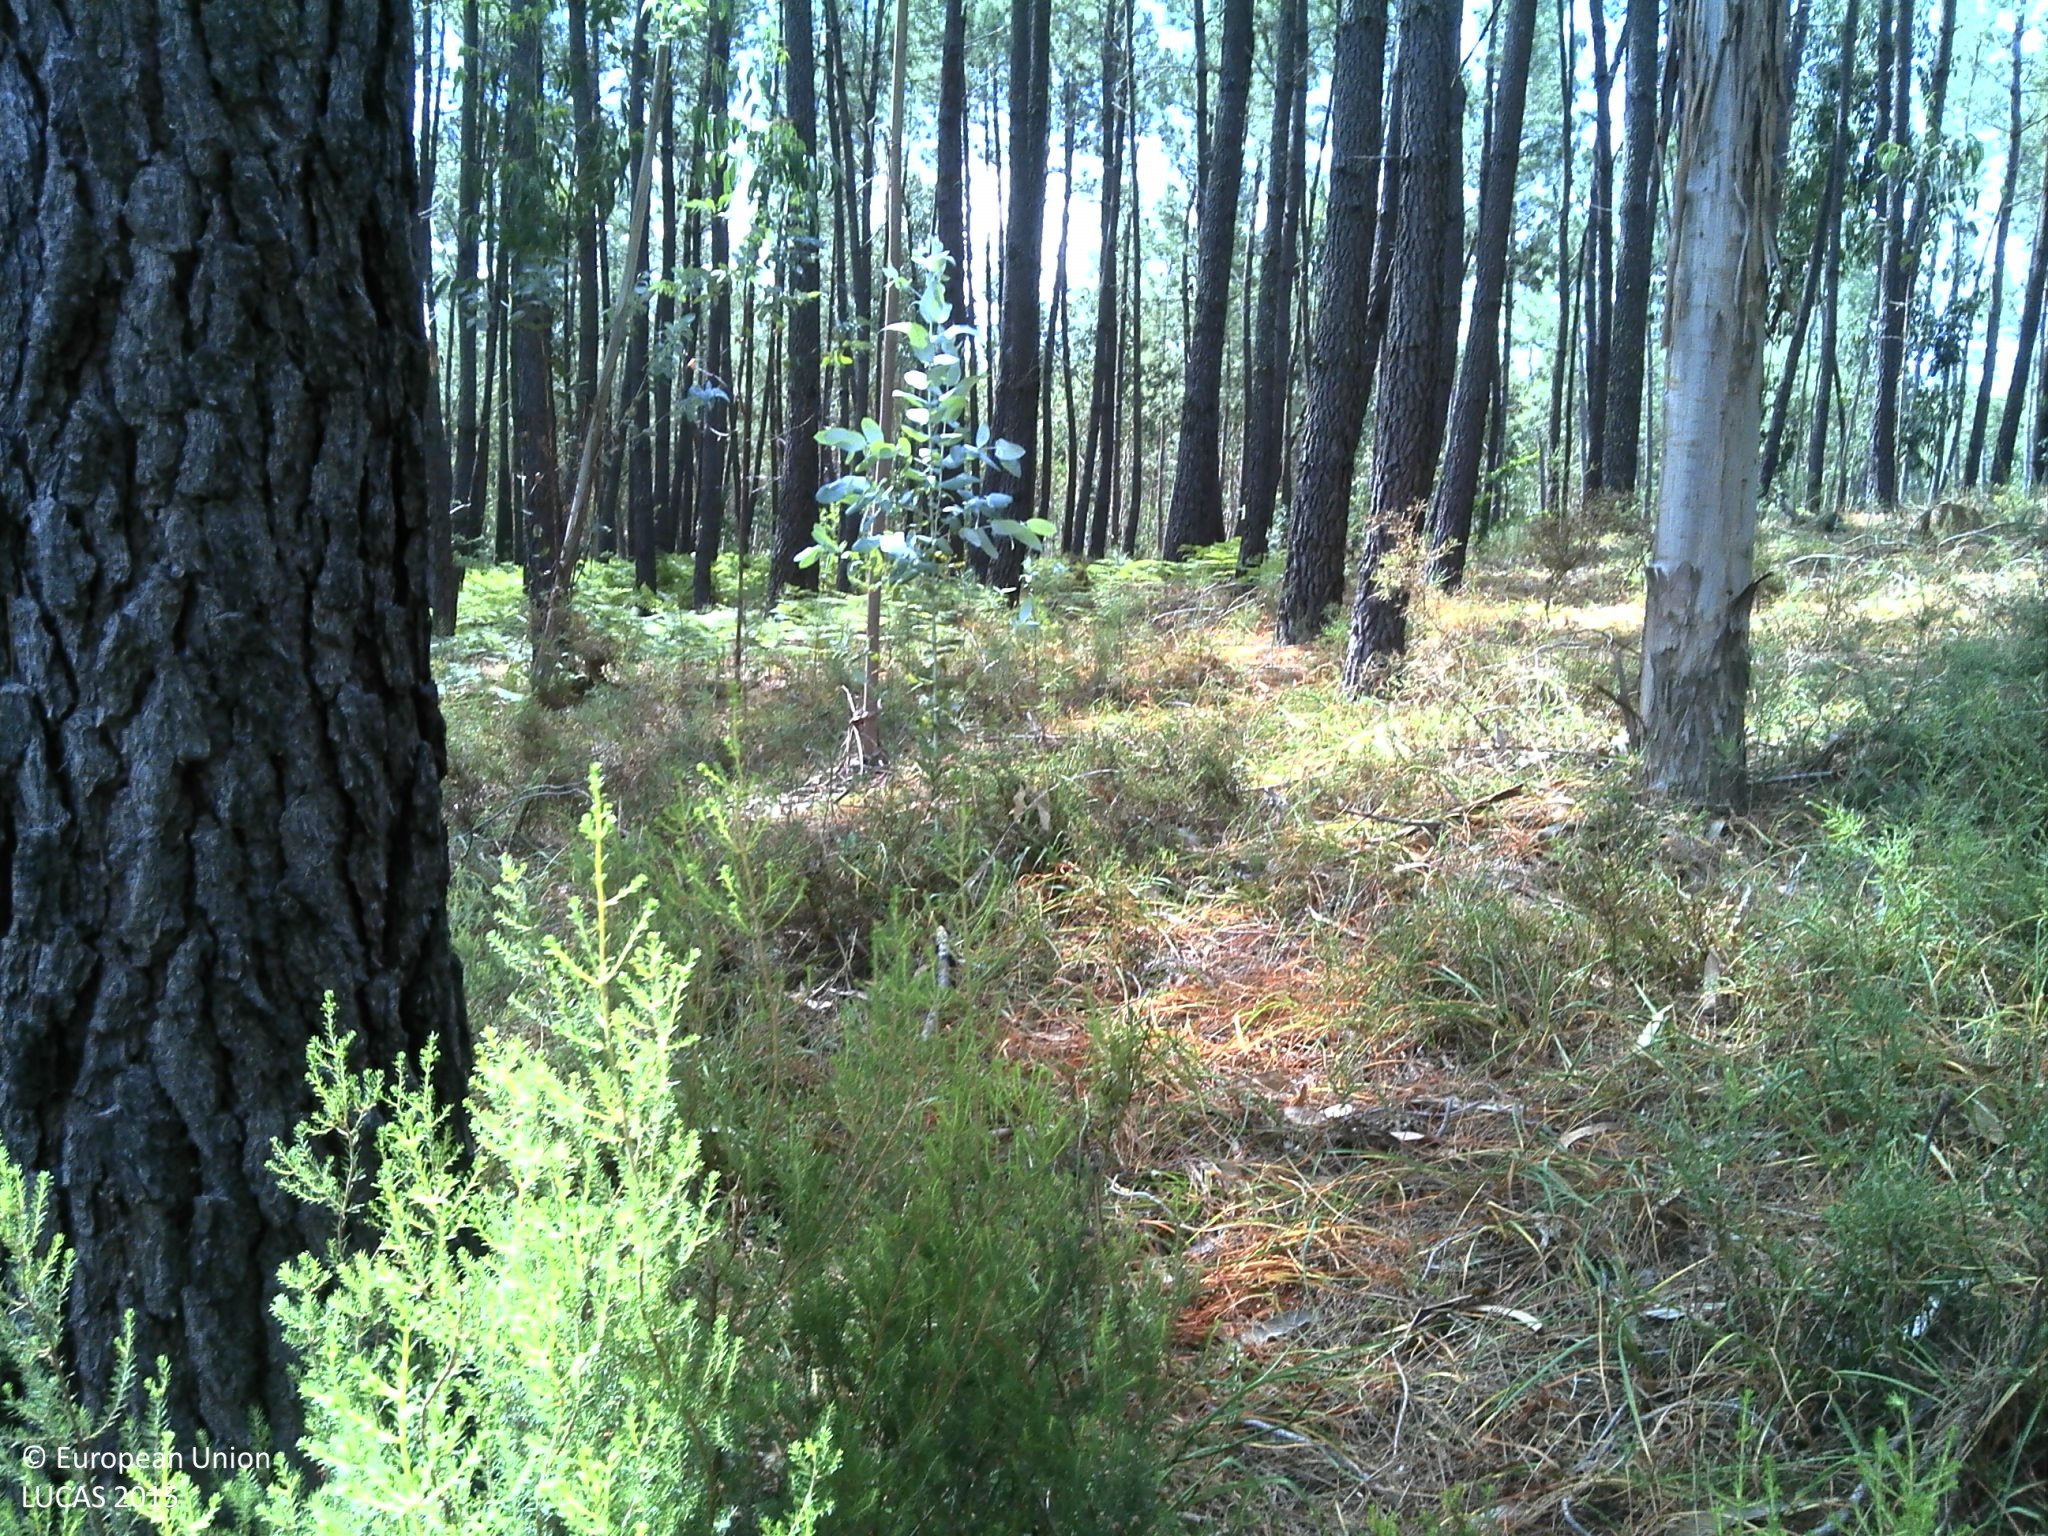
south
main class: Woodland
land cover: Pine dominated mixed woodland
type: coniferous forest of the mediterranean region
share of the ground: 25 - 50 %
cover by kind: shrubs 40 %, coniferous forest trees 15 %, broadleaved forest trees 10 %, consolidated bare surface 10 %, unconsolidated bare surface 10 %
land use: Forestry
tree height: > 5 m
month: July
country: PT
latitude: 39.8959
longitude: -8.1156
